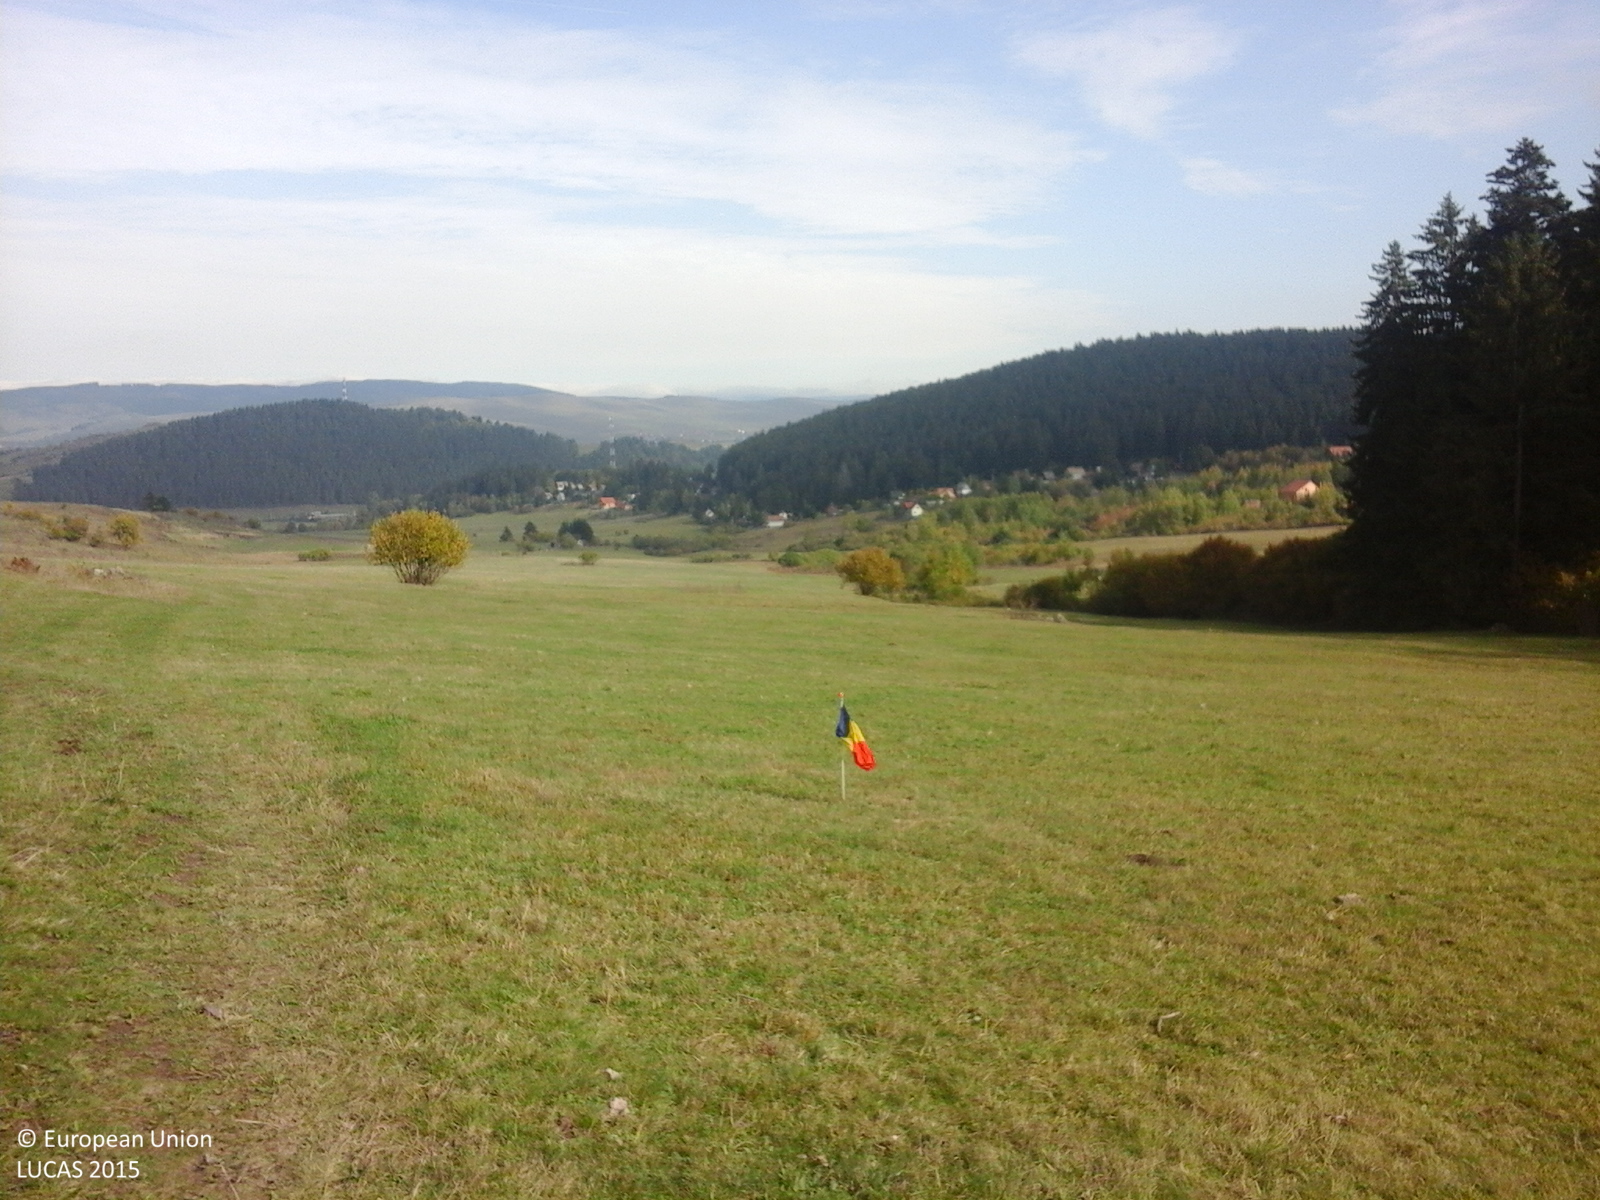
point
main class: Grassland
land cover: Grassland without tree/shrub cover
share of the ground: > 75 %
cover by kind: herbaceous plants 100 %
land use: Agriculture (excluding fallow land and kitchen gardens)
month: October
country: RO
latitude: 46.3241
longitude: 25.7916
